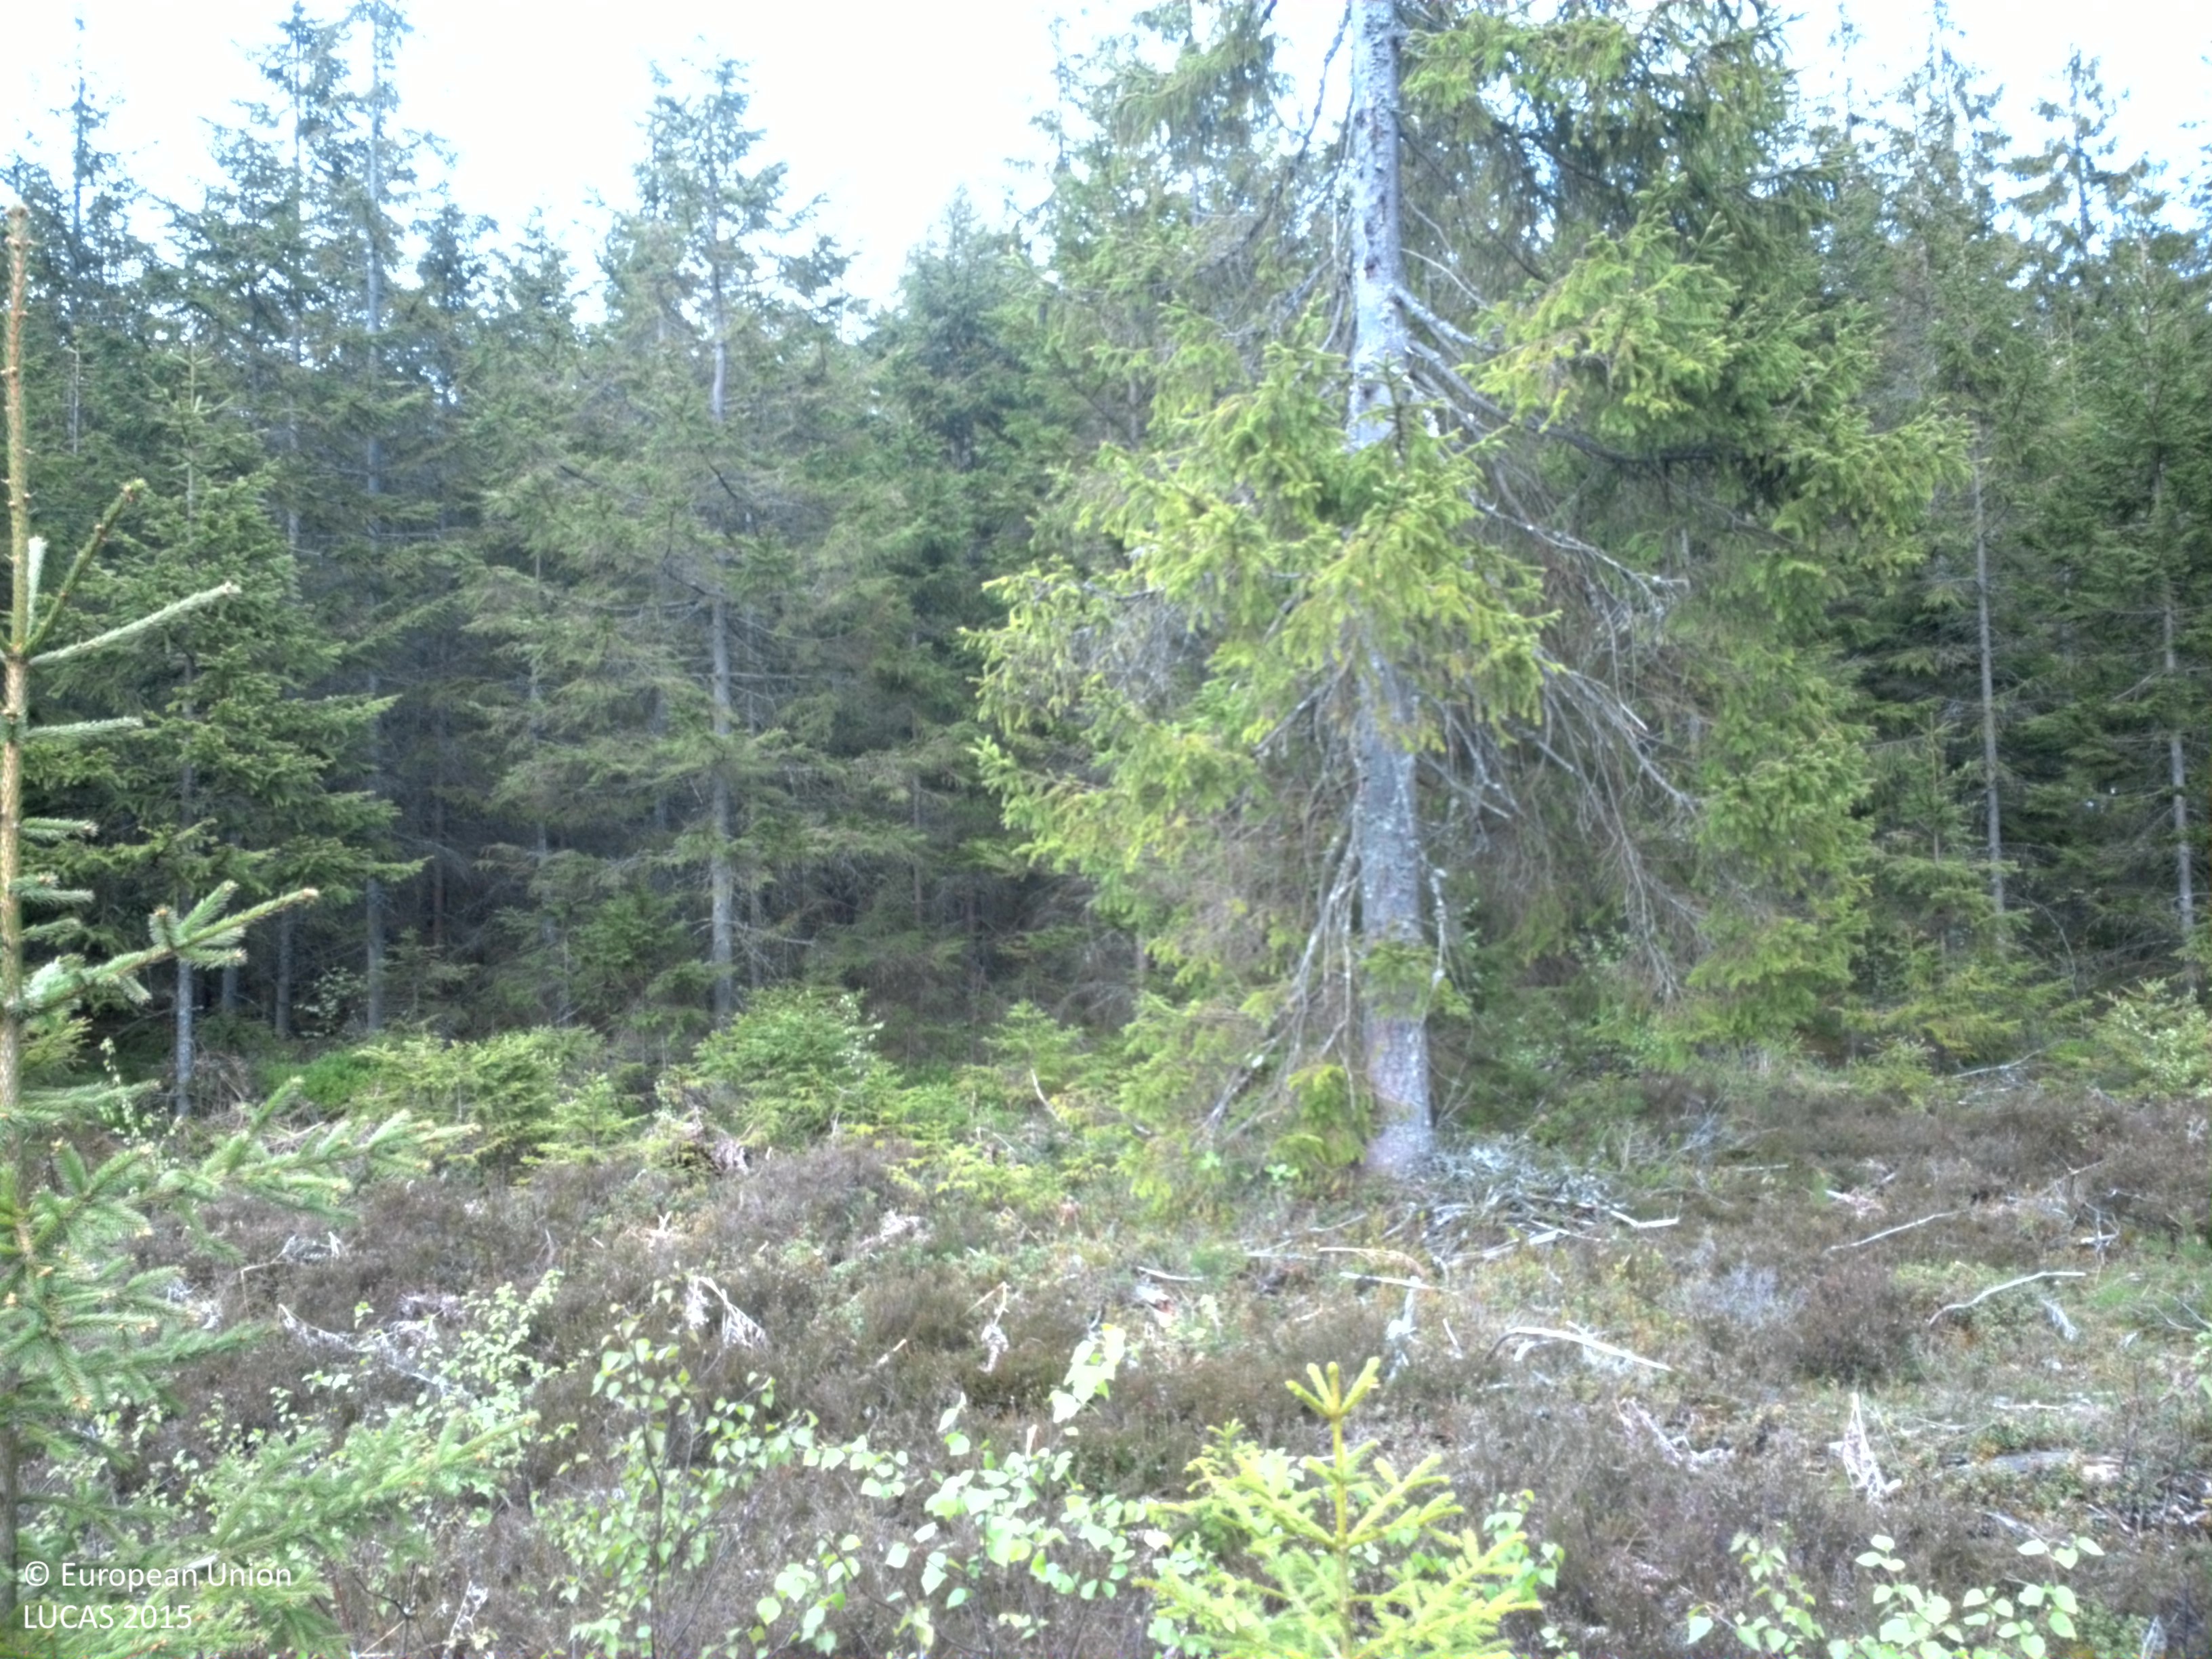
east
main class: Woodland
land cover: Spruce dominated mixed woodland
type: boreal forest
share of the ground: > 75 %
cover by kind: coniferous forest trees 40 %, broadleaved forest trees 40 %, shrubs 10 %, herbaceous plants 10 %
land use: Forestry
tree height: < 5 m
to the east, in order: Spruce dominated mixed woodland; Spruce dominated coniferous woodland; Shrubland with sparse tree cover; Grassland with sparse tree/shrub cover; Tracks; Shrubland with sparse tree cover
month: May
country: SE
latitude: 56.8010
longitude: 15.2544
